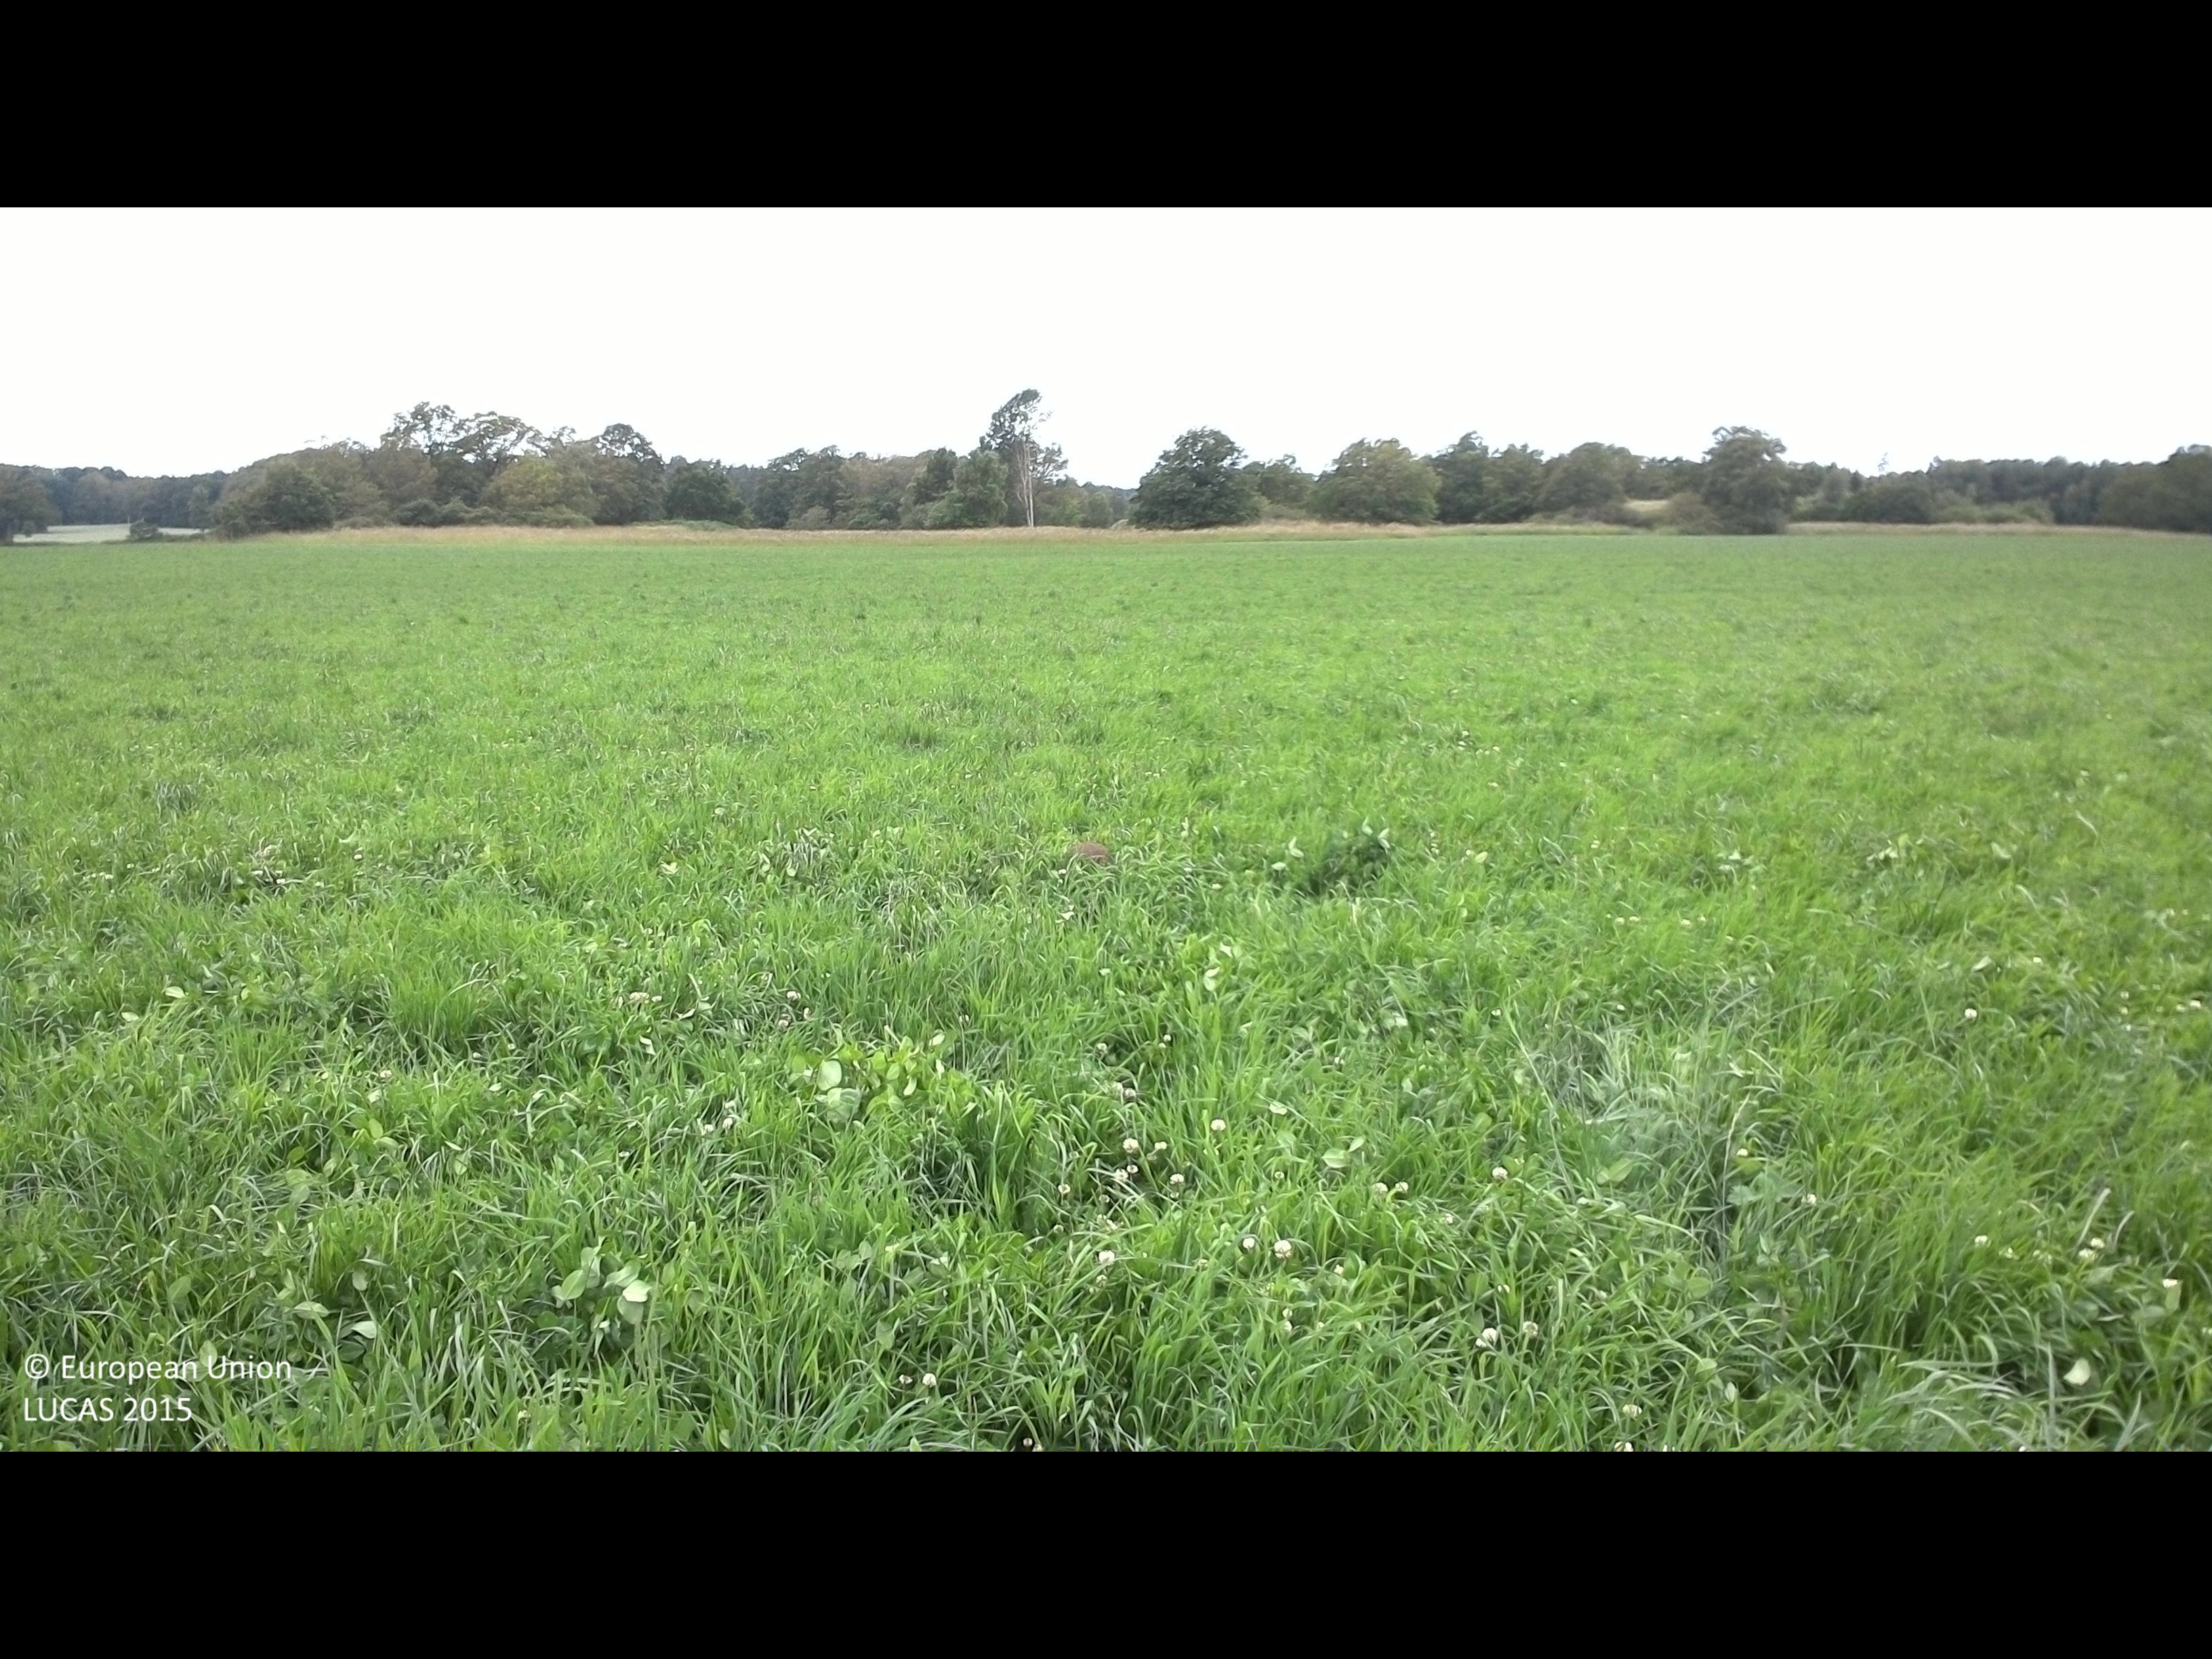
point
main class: Cropland
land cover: Other leguminous and mixtures for fodder
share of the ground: > 75 %
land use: Agriculture (excluding fallow land and kitchen gardens)
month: June
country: SE
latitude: 56.5283
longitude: 16.1296
